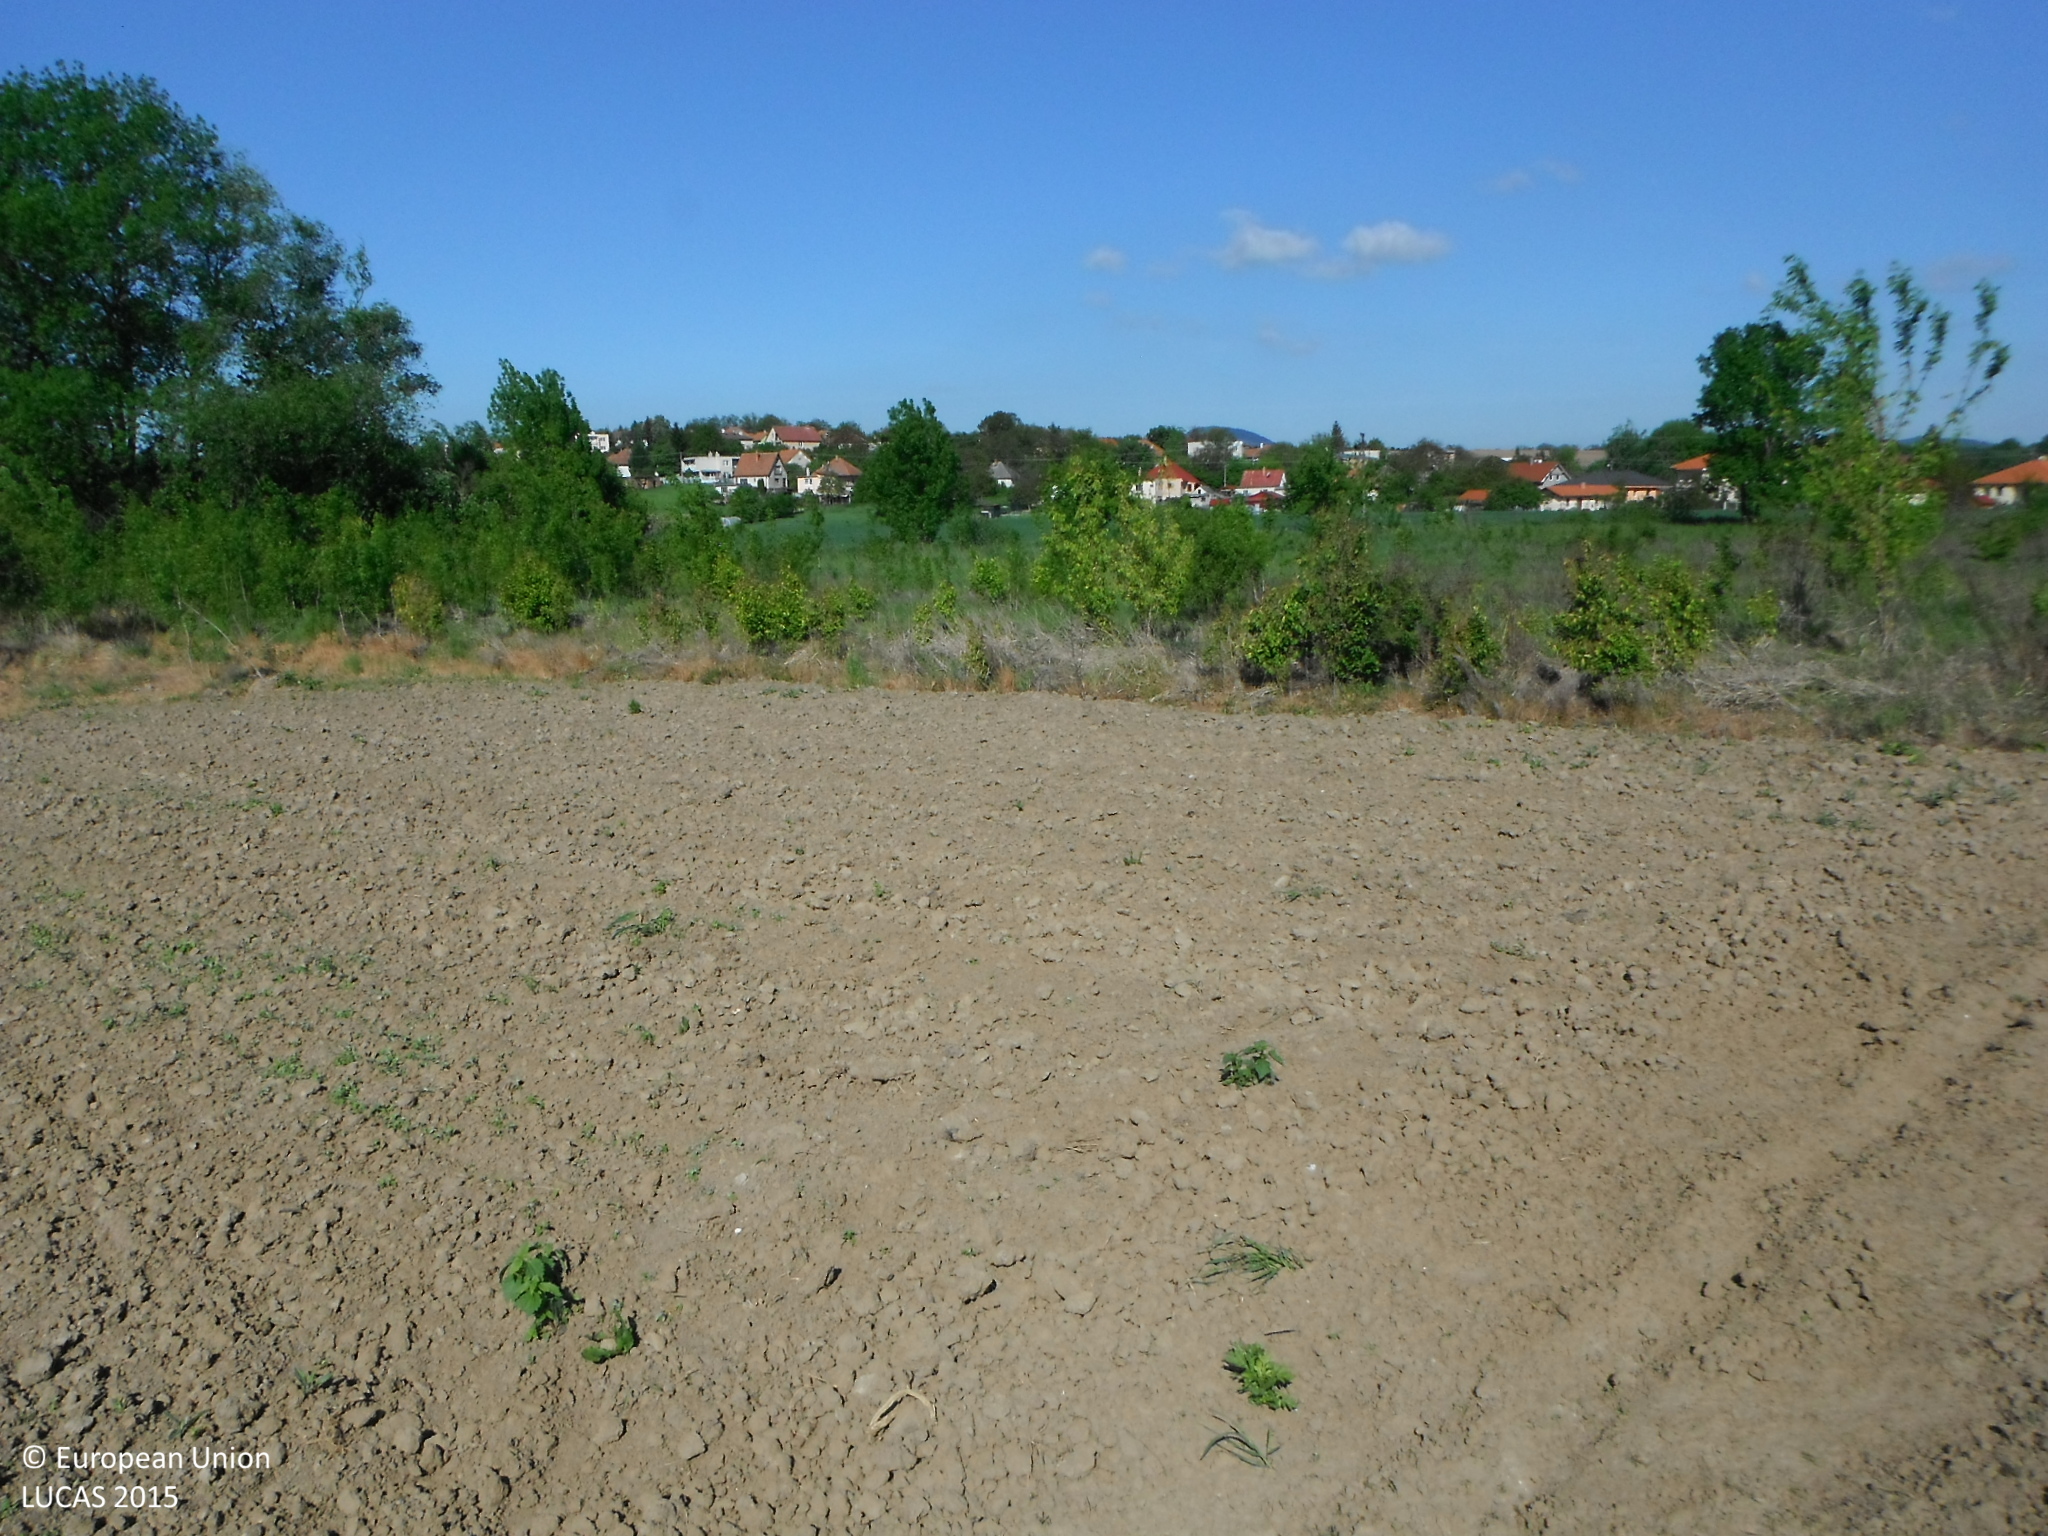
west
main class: Cropland
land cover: Other root crops
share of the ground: 10 - 25 %
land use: Kitchen garden
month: May
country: SK
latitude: 48.3453
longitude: 18.2860
